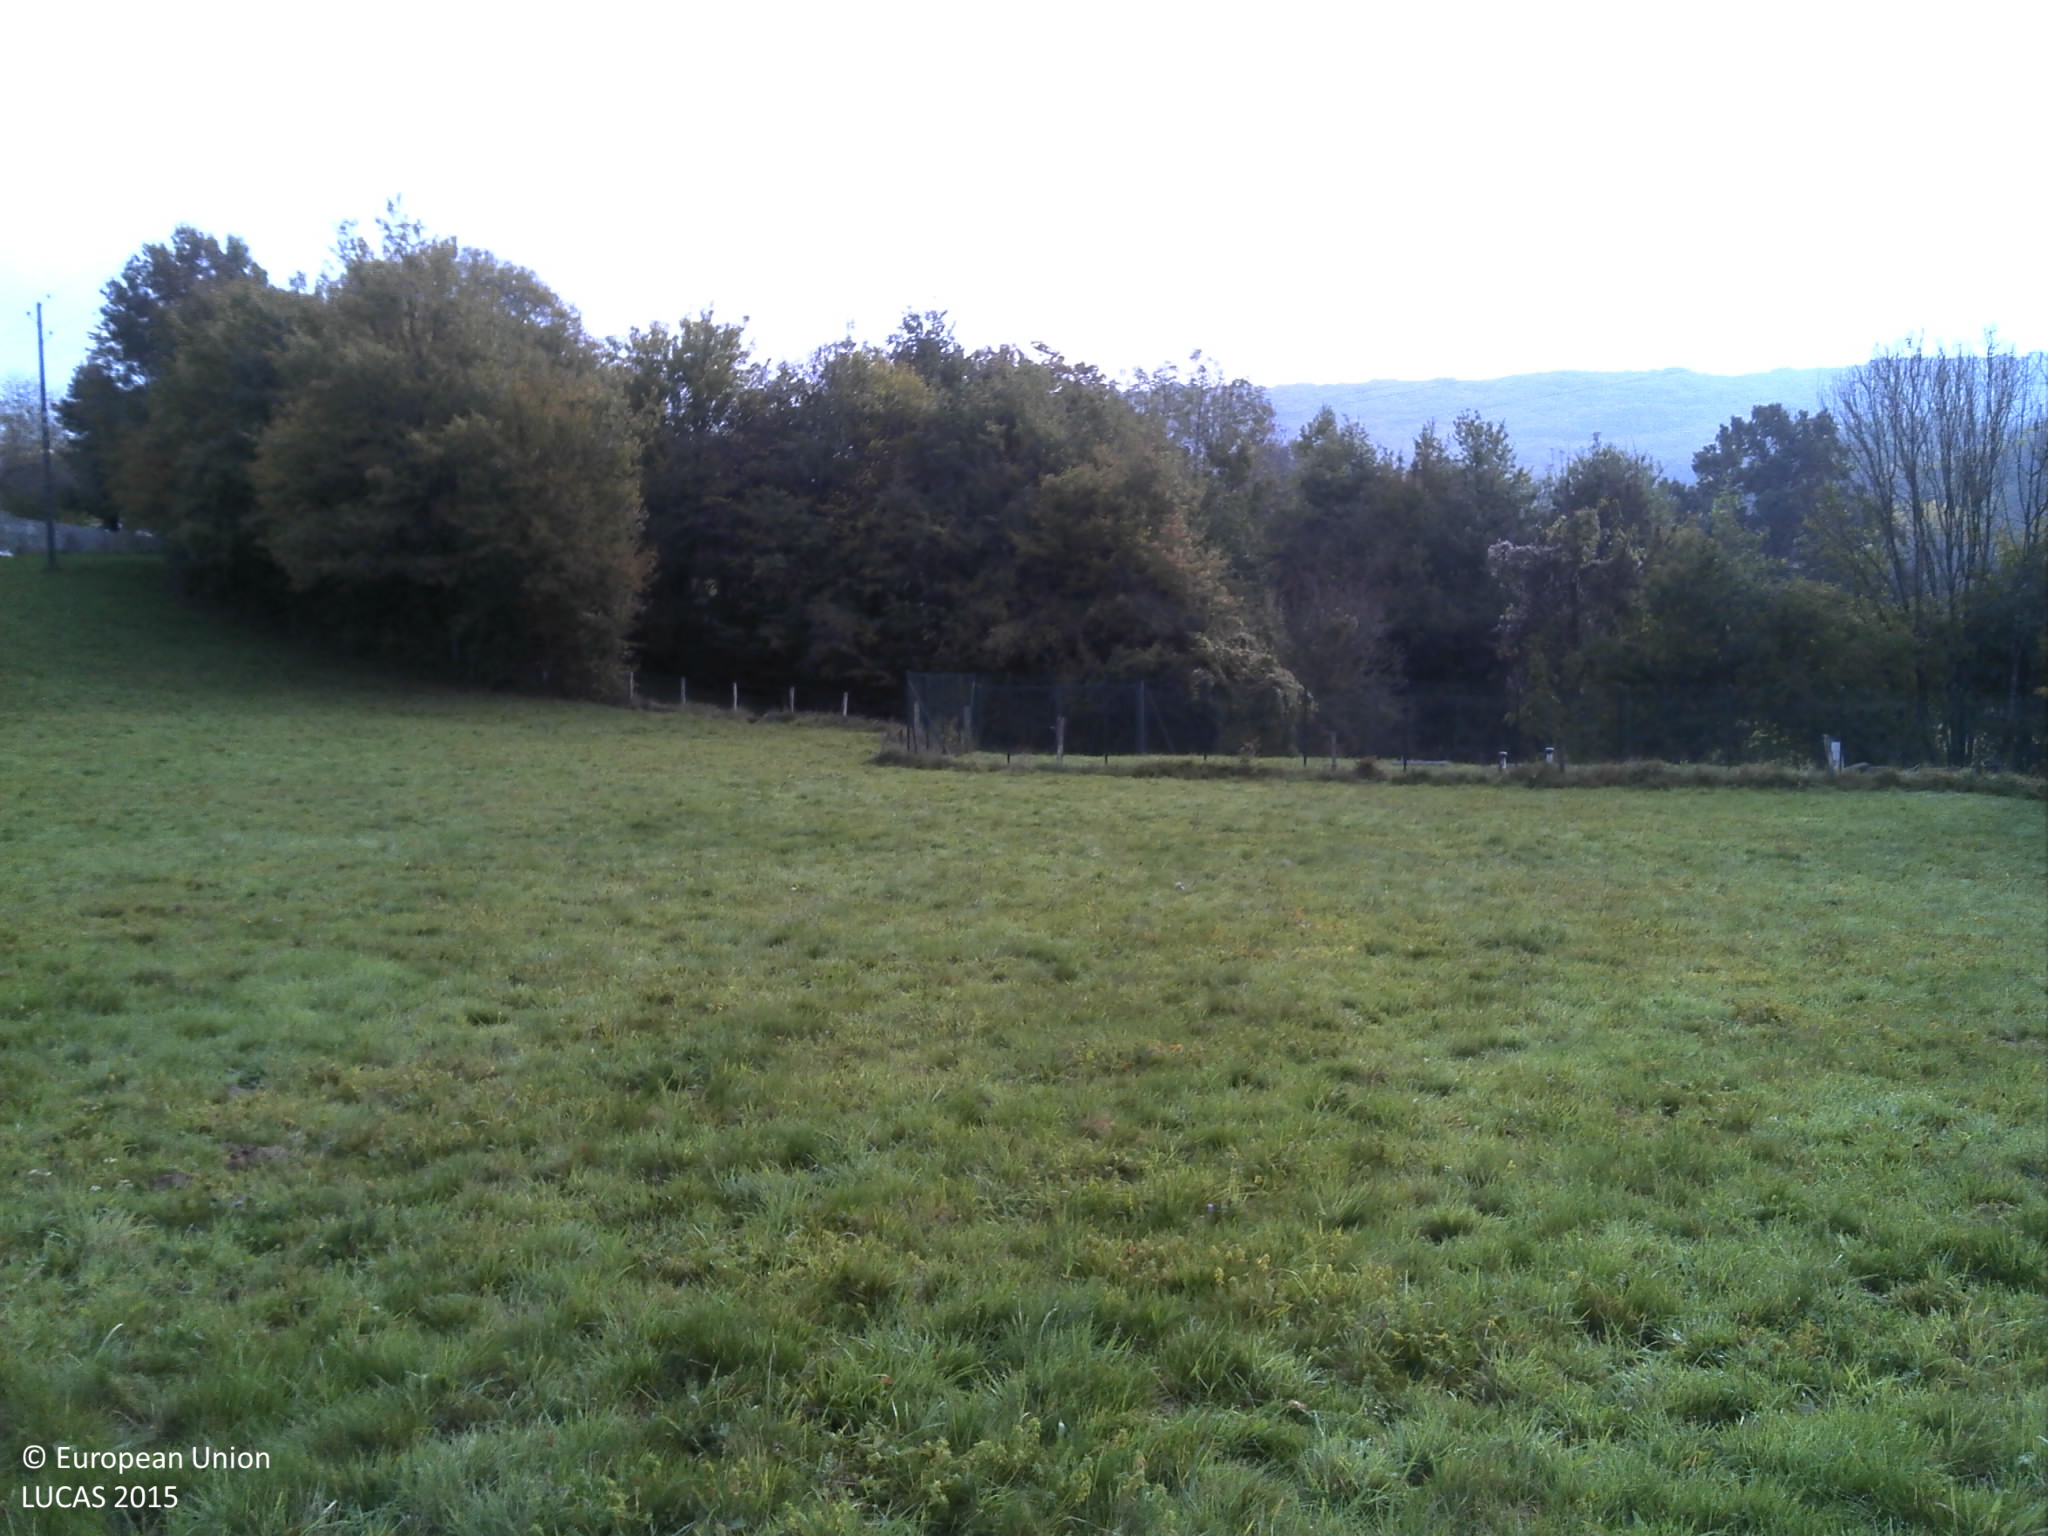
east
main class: Grassland
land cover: Grassland without tree/shrub cover
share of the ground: > 75 %
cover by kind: herbaceous plants 100 %
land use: Agriculture (excluding fallow land and kitchen gardens)
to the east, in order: Grassland without tree/shrub cover; Electric lines; Grassland without tree/shrub cover; Fences; Grass margins; Paved roads, cycling and walking lanes; Grass margins; Fences; Broadleaved woodland; Grassland without tree/shrub cover; Broadleaved woodland; Grassland without tree/shrub cover; Fences; Lines of trees; Maize; Electric lines; Maize
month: October
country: FR
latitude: 46.1073
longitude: 5.3846
